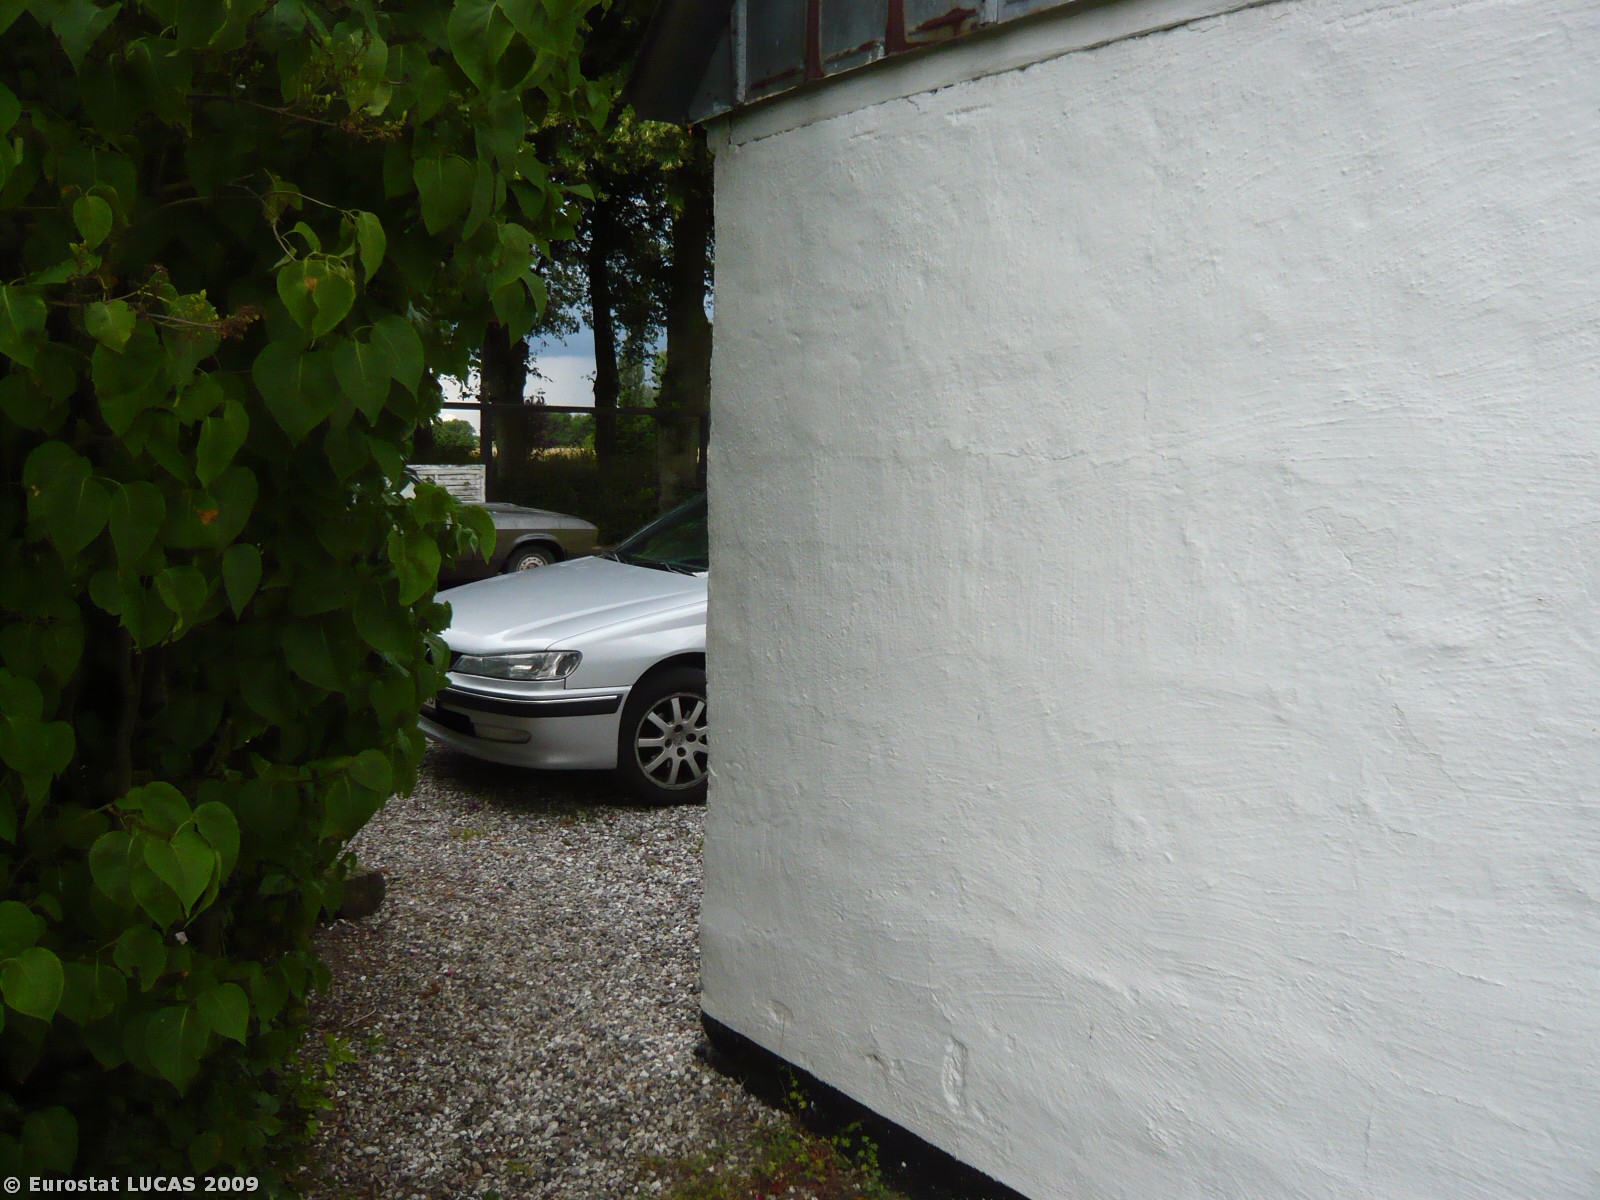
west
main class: Grassland
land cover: Grassland without tree/shrub cover
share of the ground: > 75 %
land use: Agriculture (excluding fallow land and kitchen gardens)
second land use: Amenities, museums, leisure
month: July
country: DK
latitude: 55.5607
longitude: 12.0119
